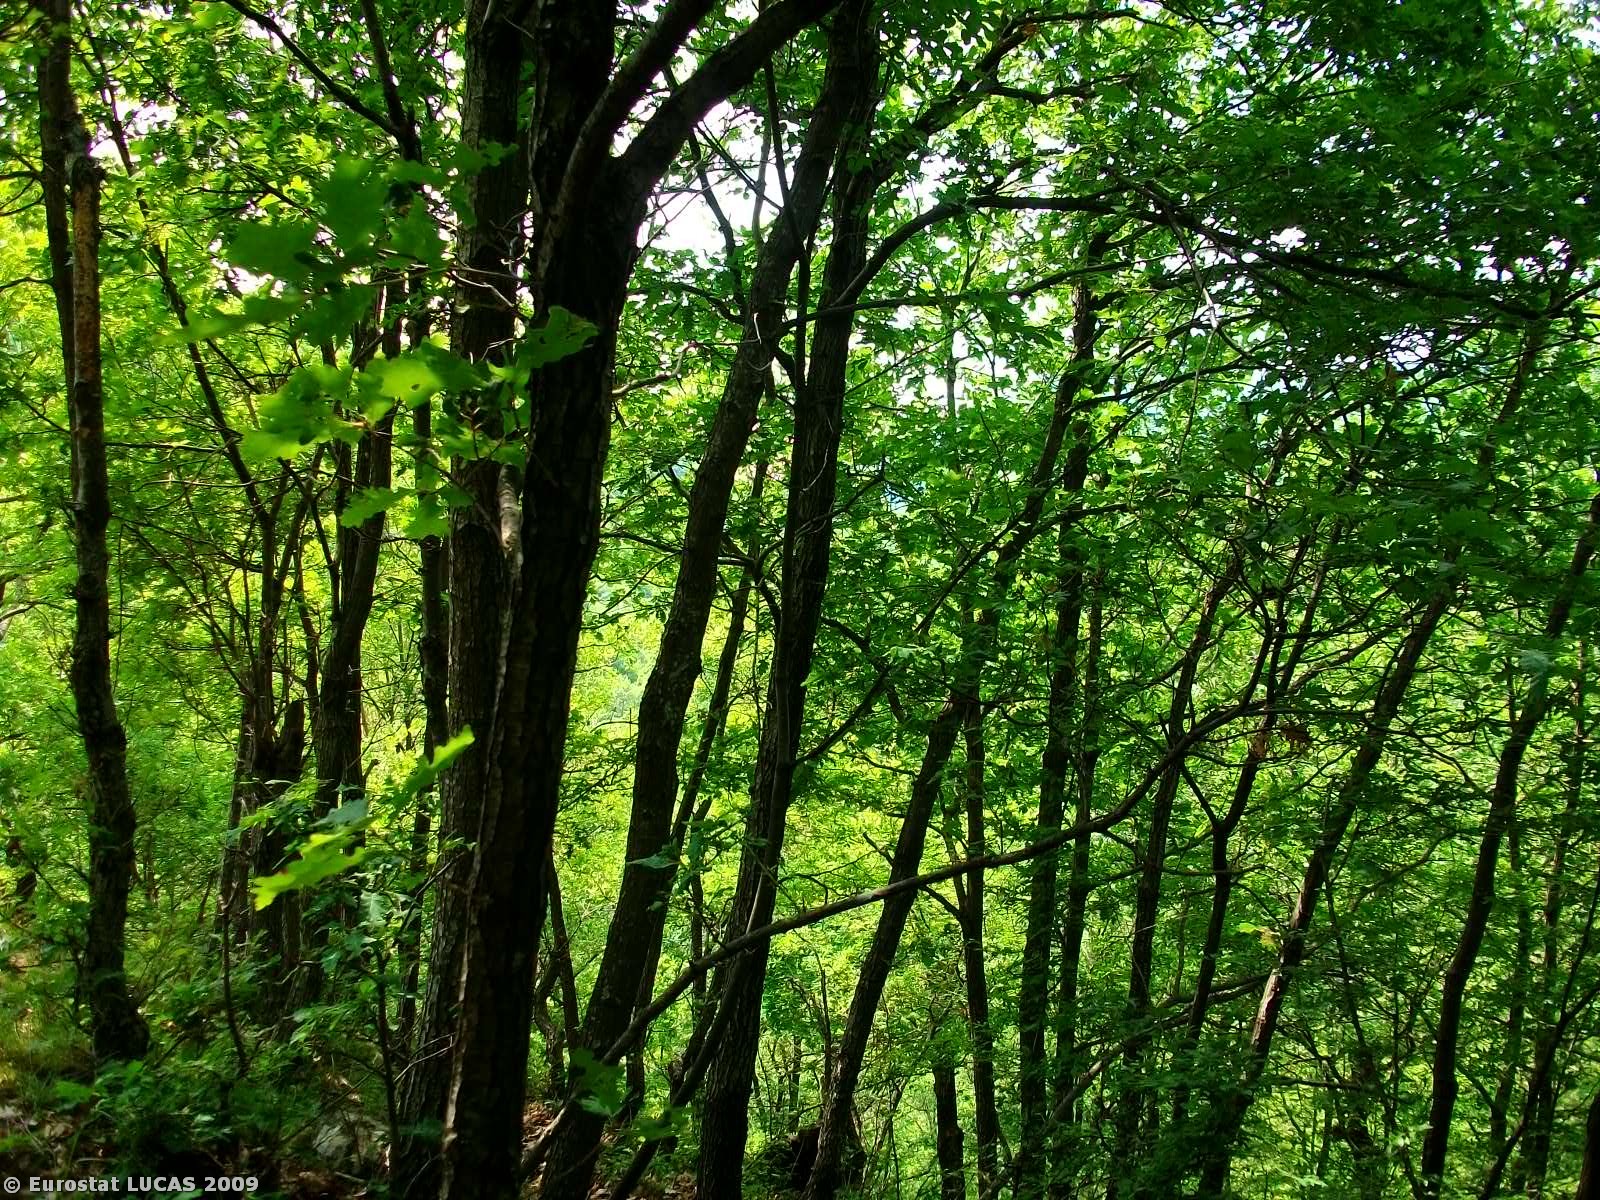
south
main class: Woodland
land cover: Broadleaved woodland
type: mesophytic deciduous forest
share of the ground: > 75 %
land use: Forestry
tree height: > 5 m
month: May
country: GR
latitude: 41.2594
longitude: 25.5596
